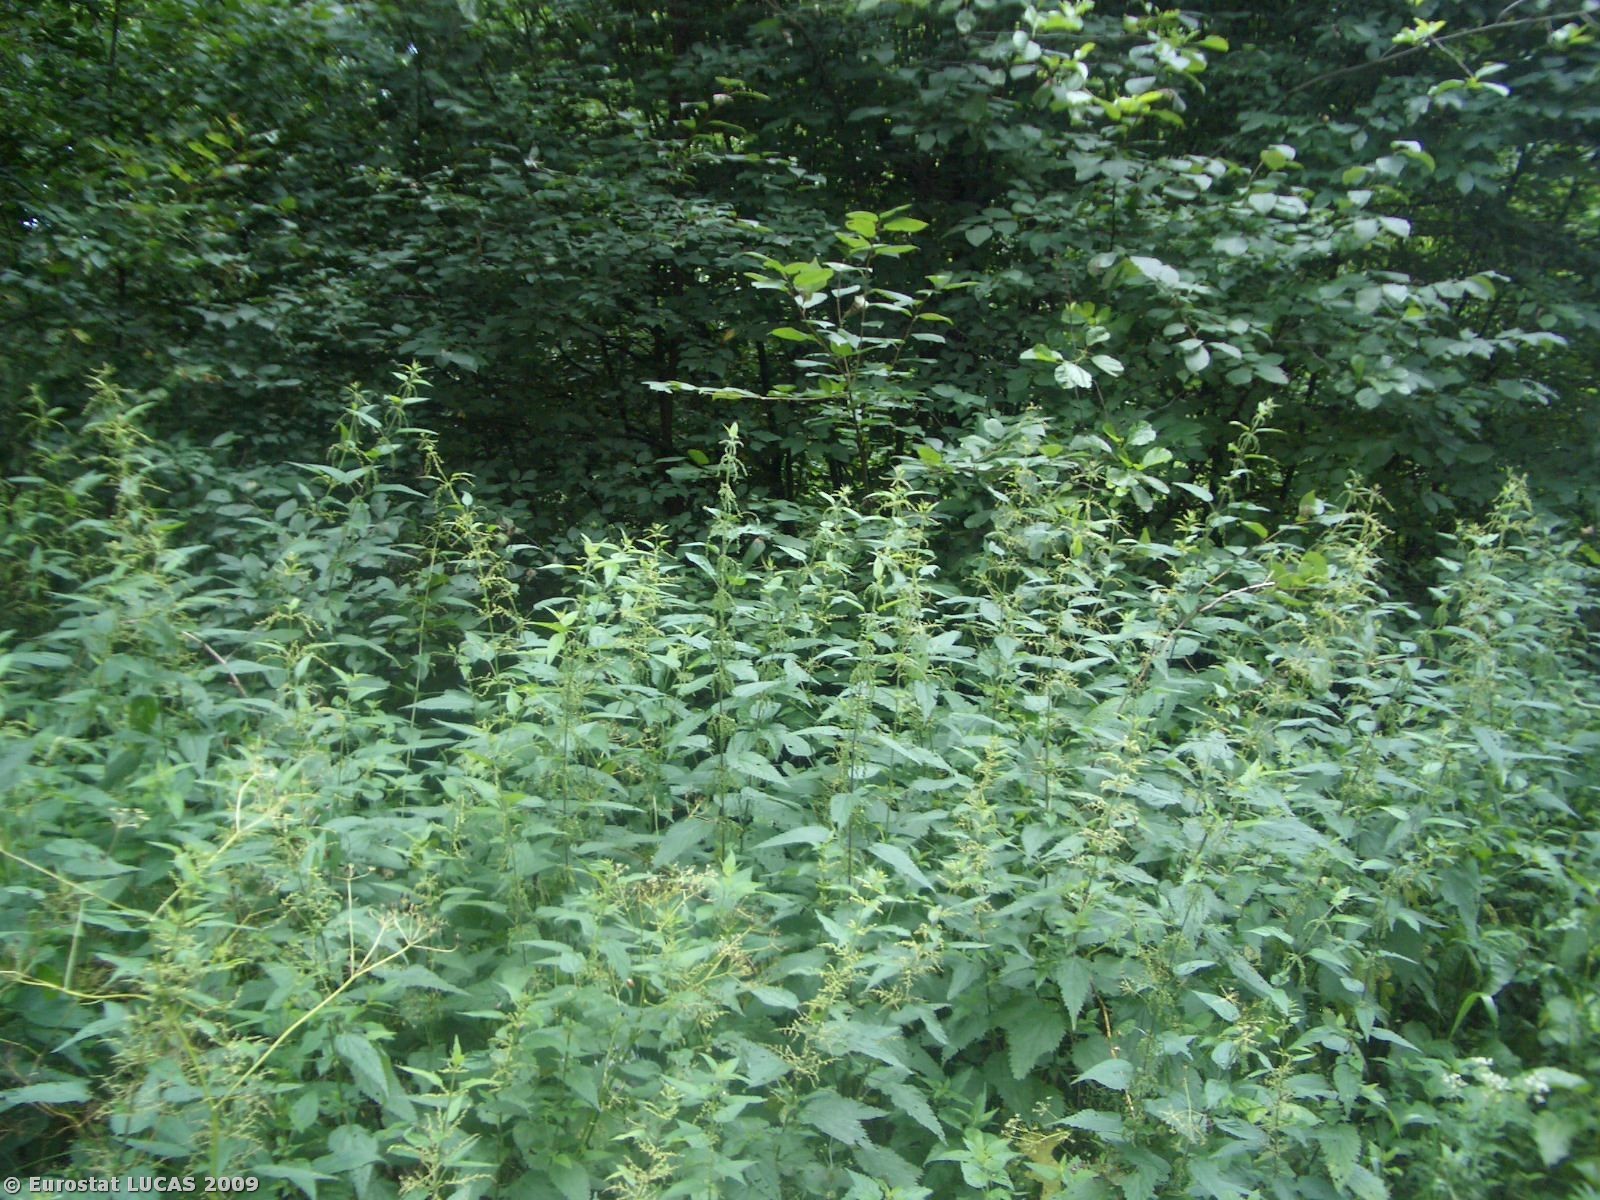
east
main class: Woodland
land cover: Mixed woodland
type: hemiboreal forest and nemoral coniferous forest and mixed broadleaved-coniferous forest
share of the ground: > 75 %
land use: Forestry
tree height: > 5 m
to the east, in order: Mixed woodland; Tracks; Mixed woodland
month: July
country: PL
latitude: 52.2699
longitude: 23.0748
